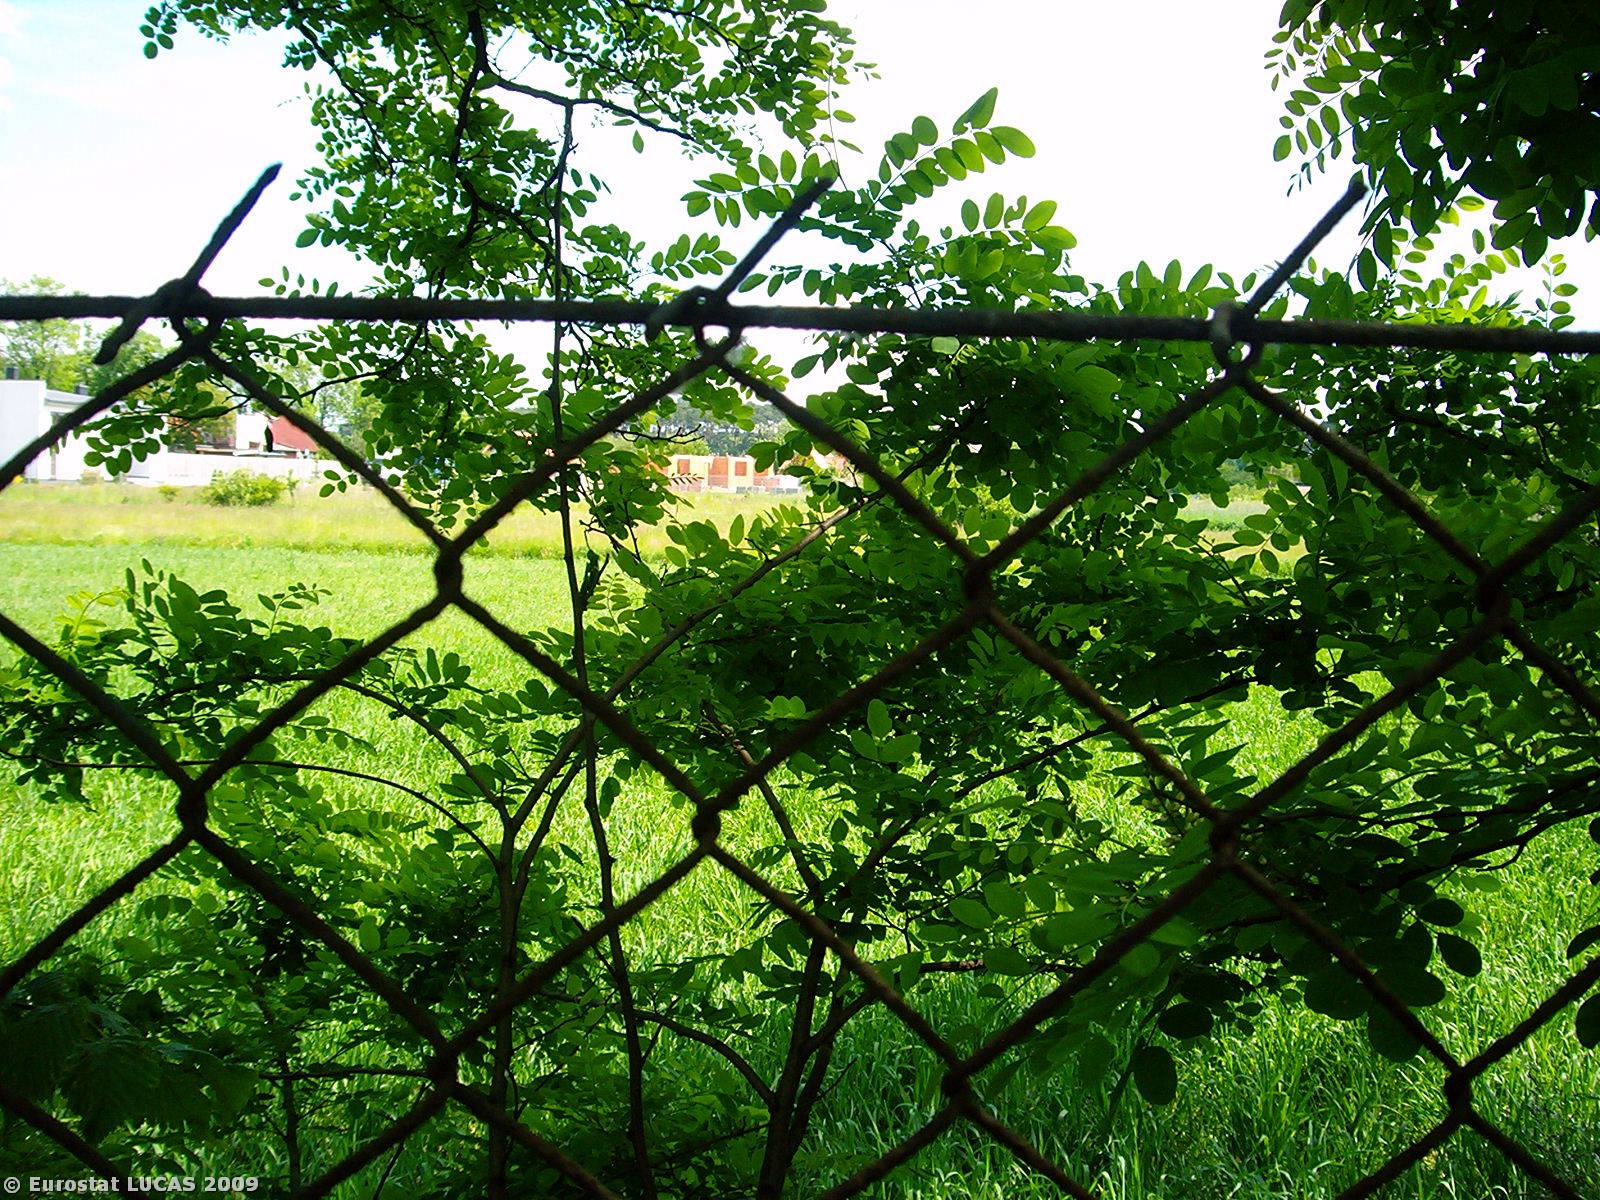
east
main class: Woodland
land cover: Broadleaved woodland
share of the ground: > 75 %
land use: Unused
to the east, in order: Broadleaved woodland; Fences; Grassland without tree/shrub cover; Paved roads, cycling and walking lanes; Fences; Grassland without tree/shrub cover; Fences; Grassland without tree/shrub cover; Electric lines; Grassland without tree/shrub cover; Tracks; Grassland without tree/shrub cover
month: May
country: PL
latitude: 52.4970
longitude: 16.9768
